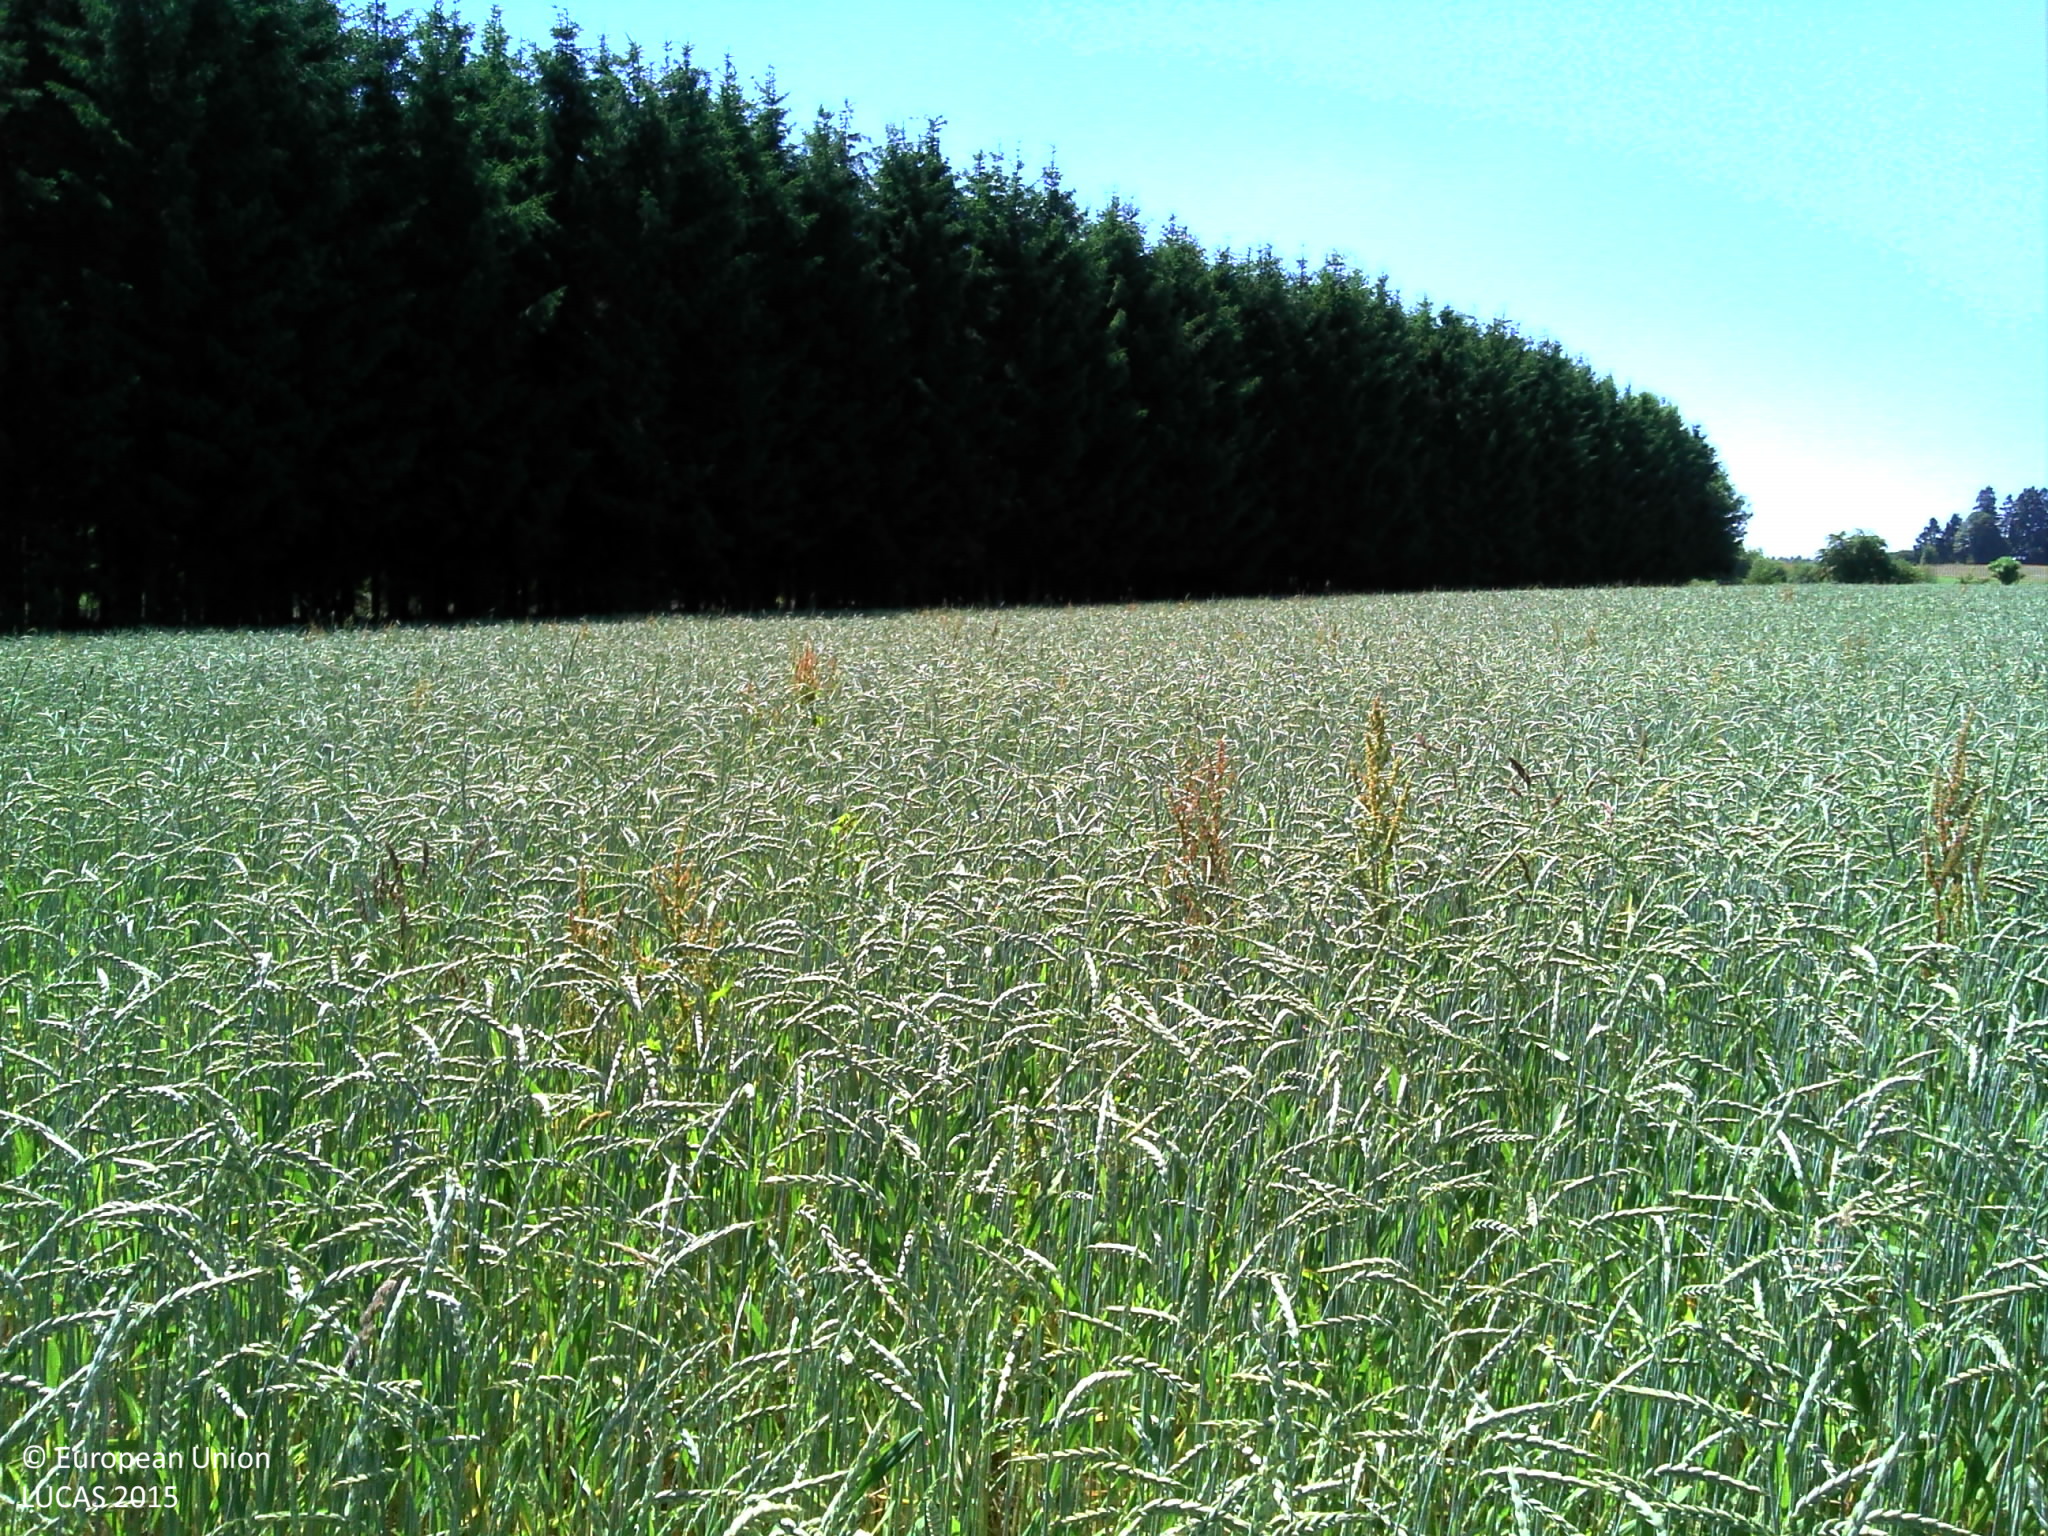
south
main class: Cropland
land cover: Common wheat
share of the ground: > 75 %
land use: Agriculture (excluding fallow land and kitchen gardens)
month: June
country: BE
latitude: 50.0062
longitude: 5.5195
